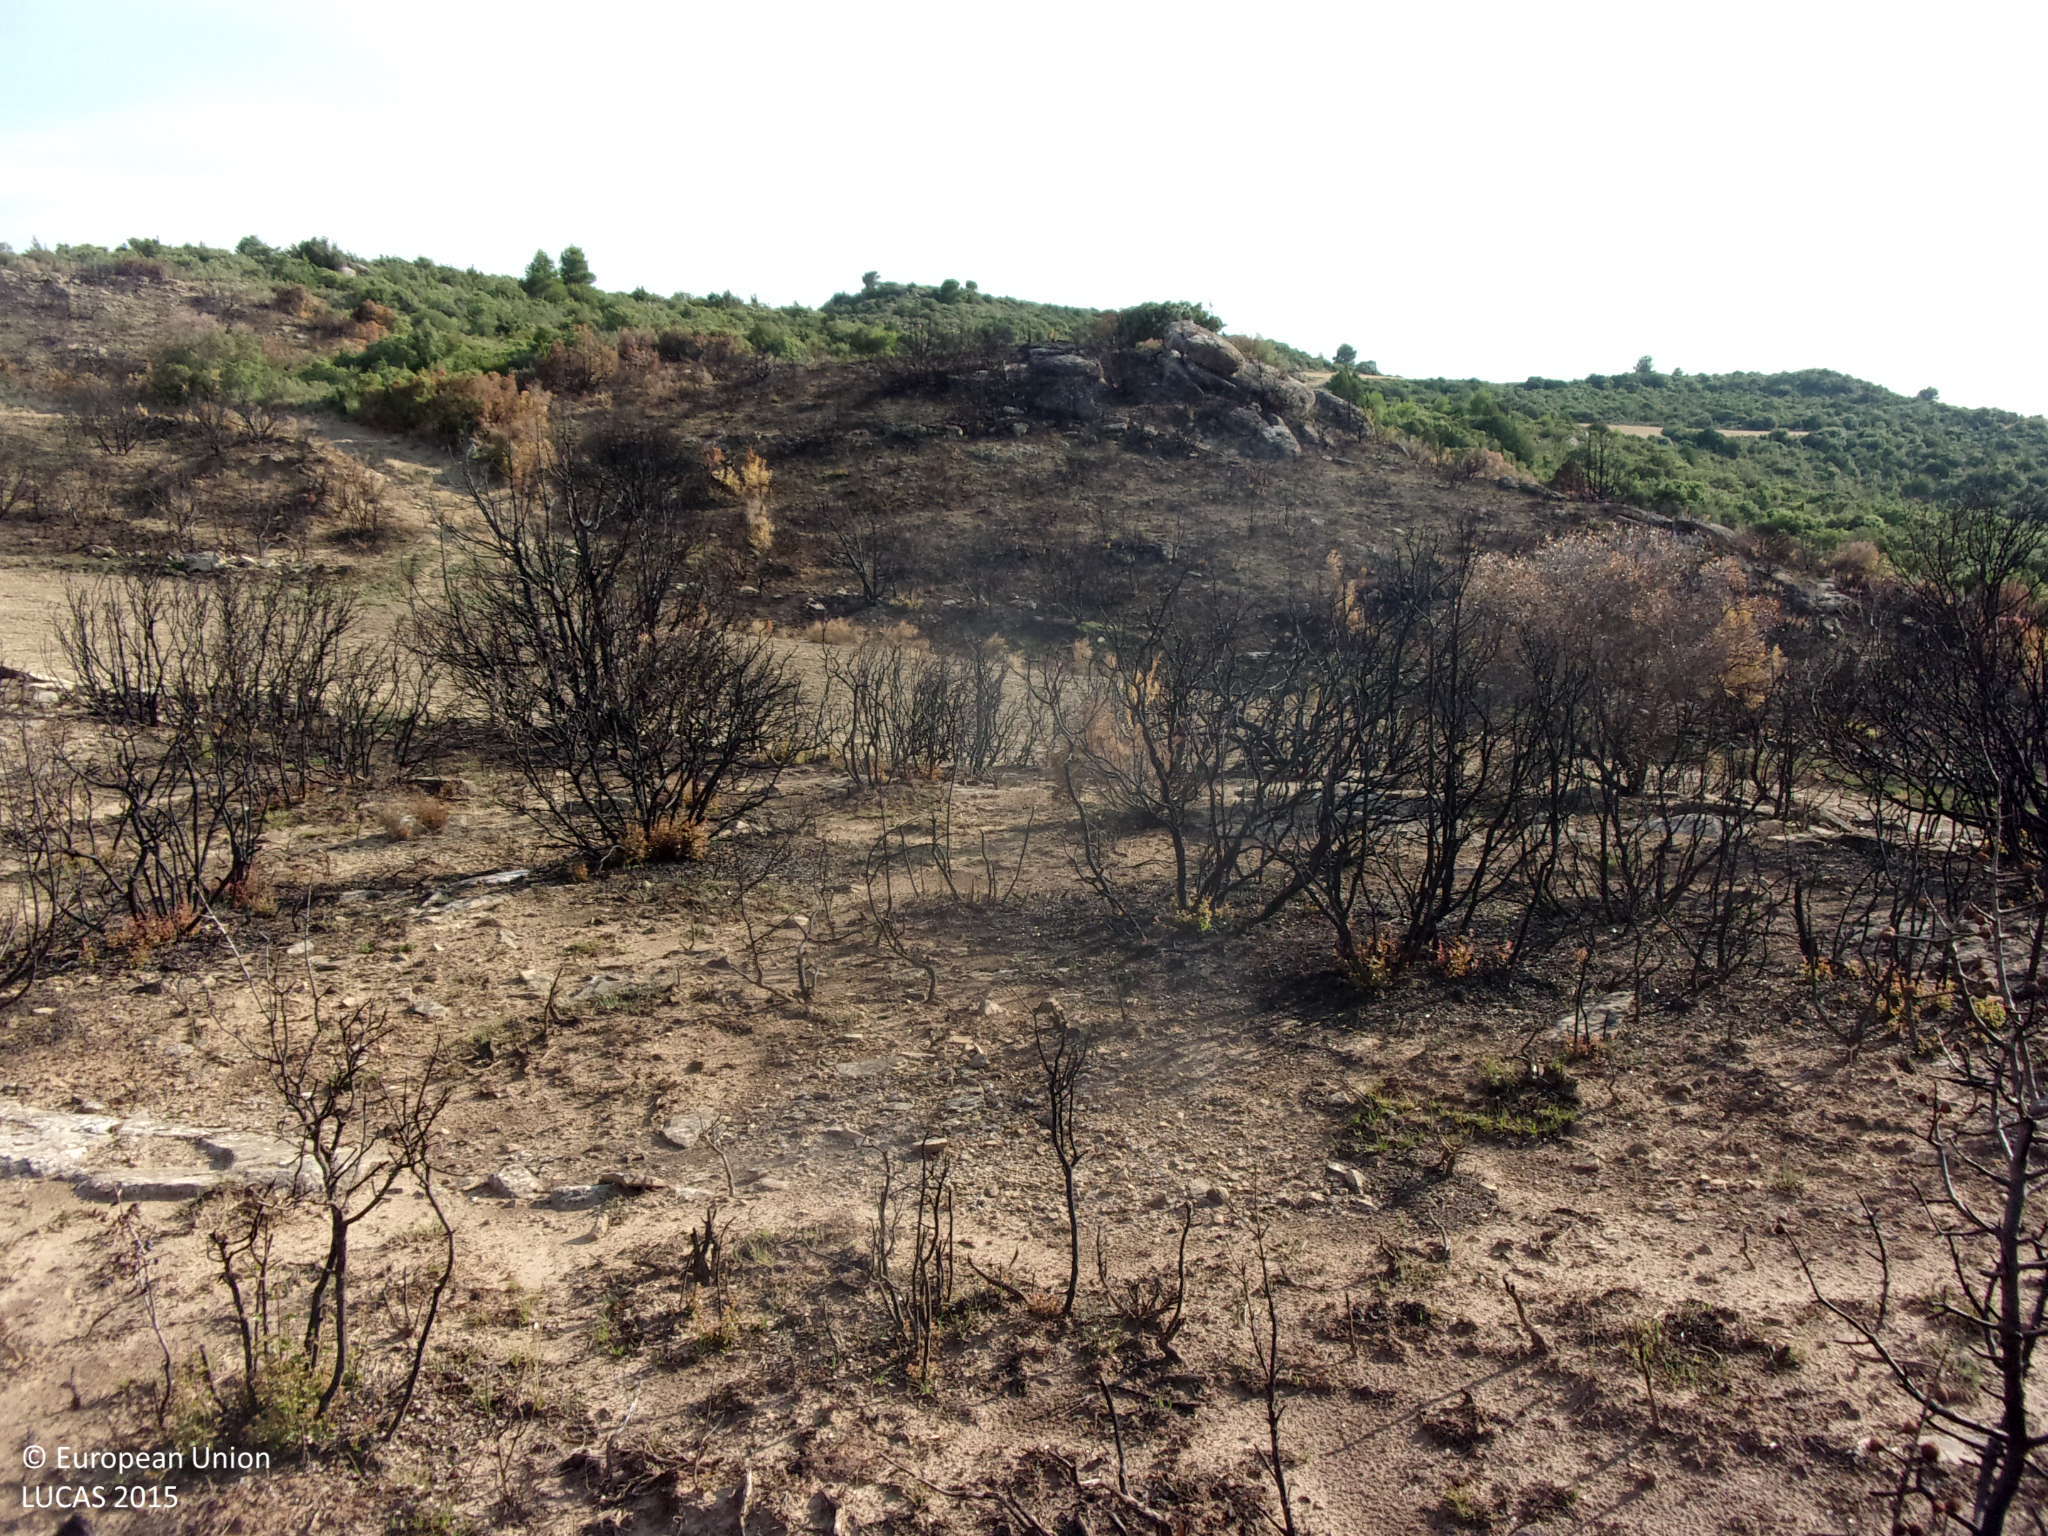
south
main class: Shrubland
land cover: Shrubland without tree cover
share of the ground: 10 - 25 %
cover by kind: unconsolidated bare surface 90 %, shrubs 10 %
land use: Semi-natural and natural areas not in use
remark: Burnt area
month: August
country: ES
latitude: 42.2100
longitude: -1.0629
